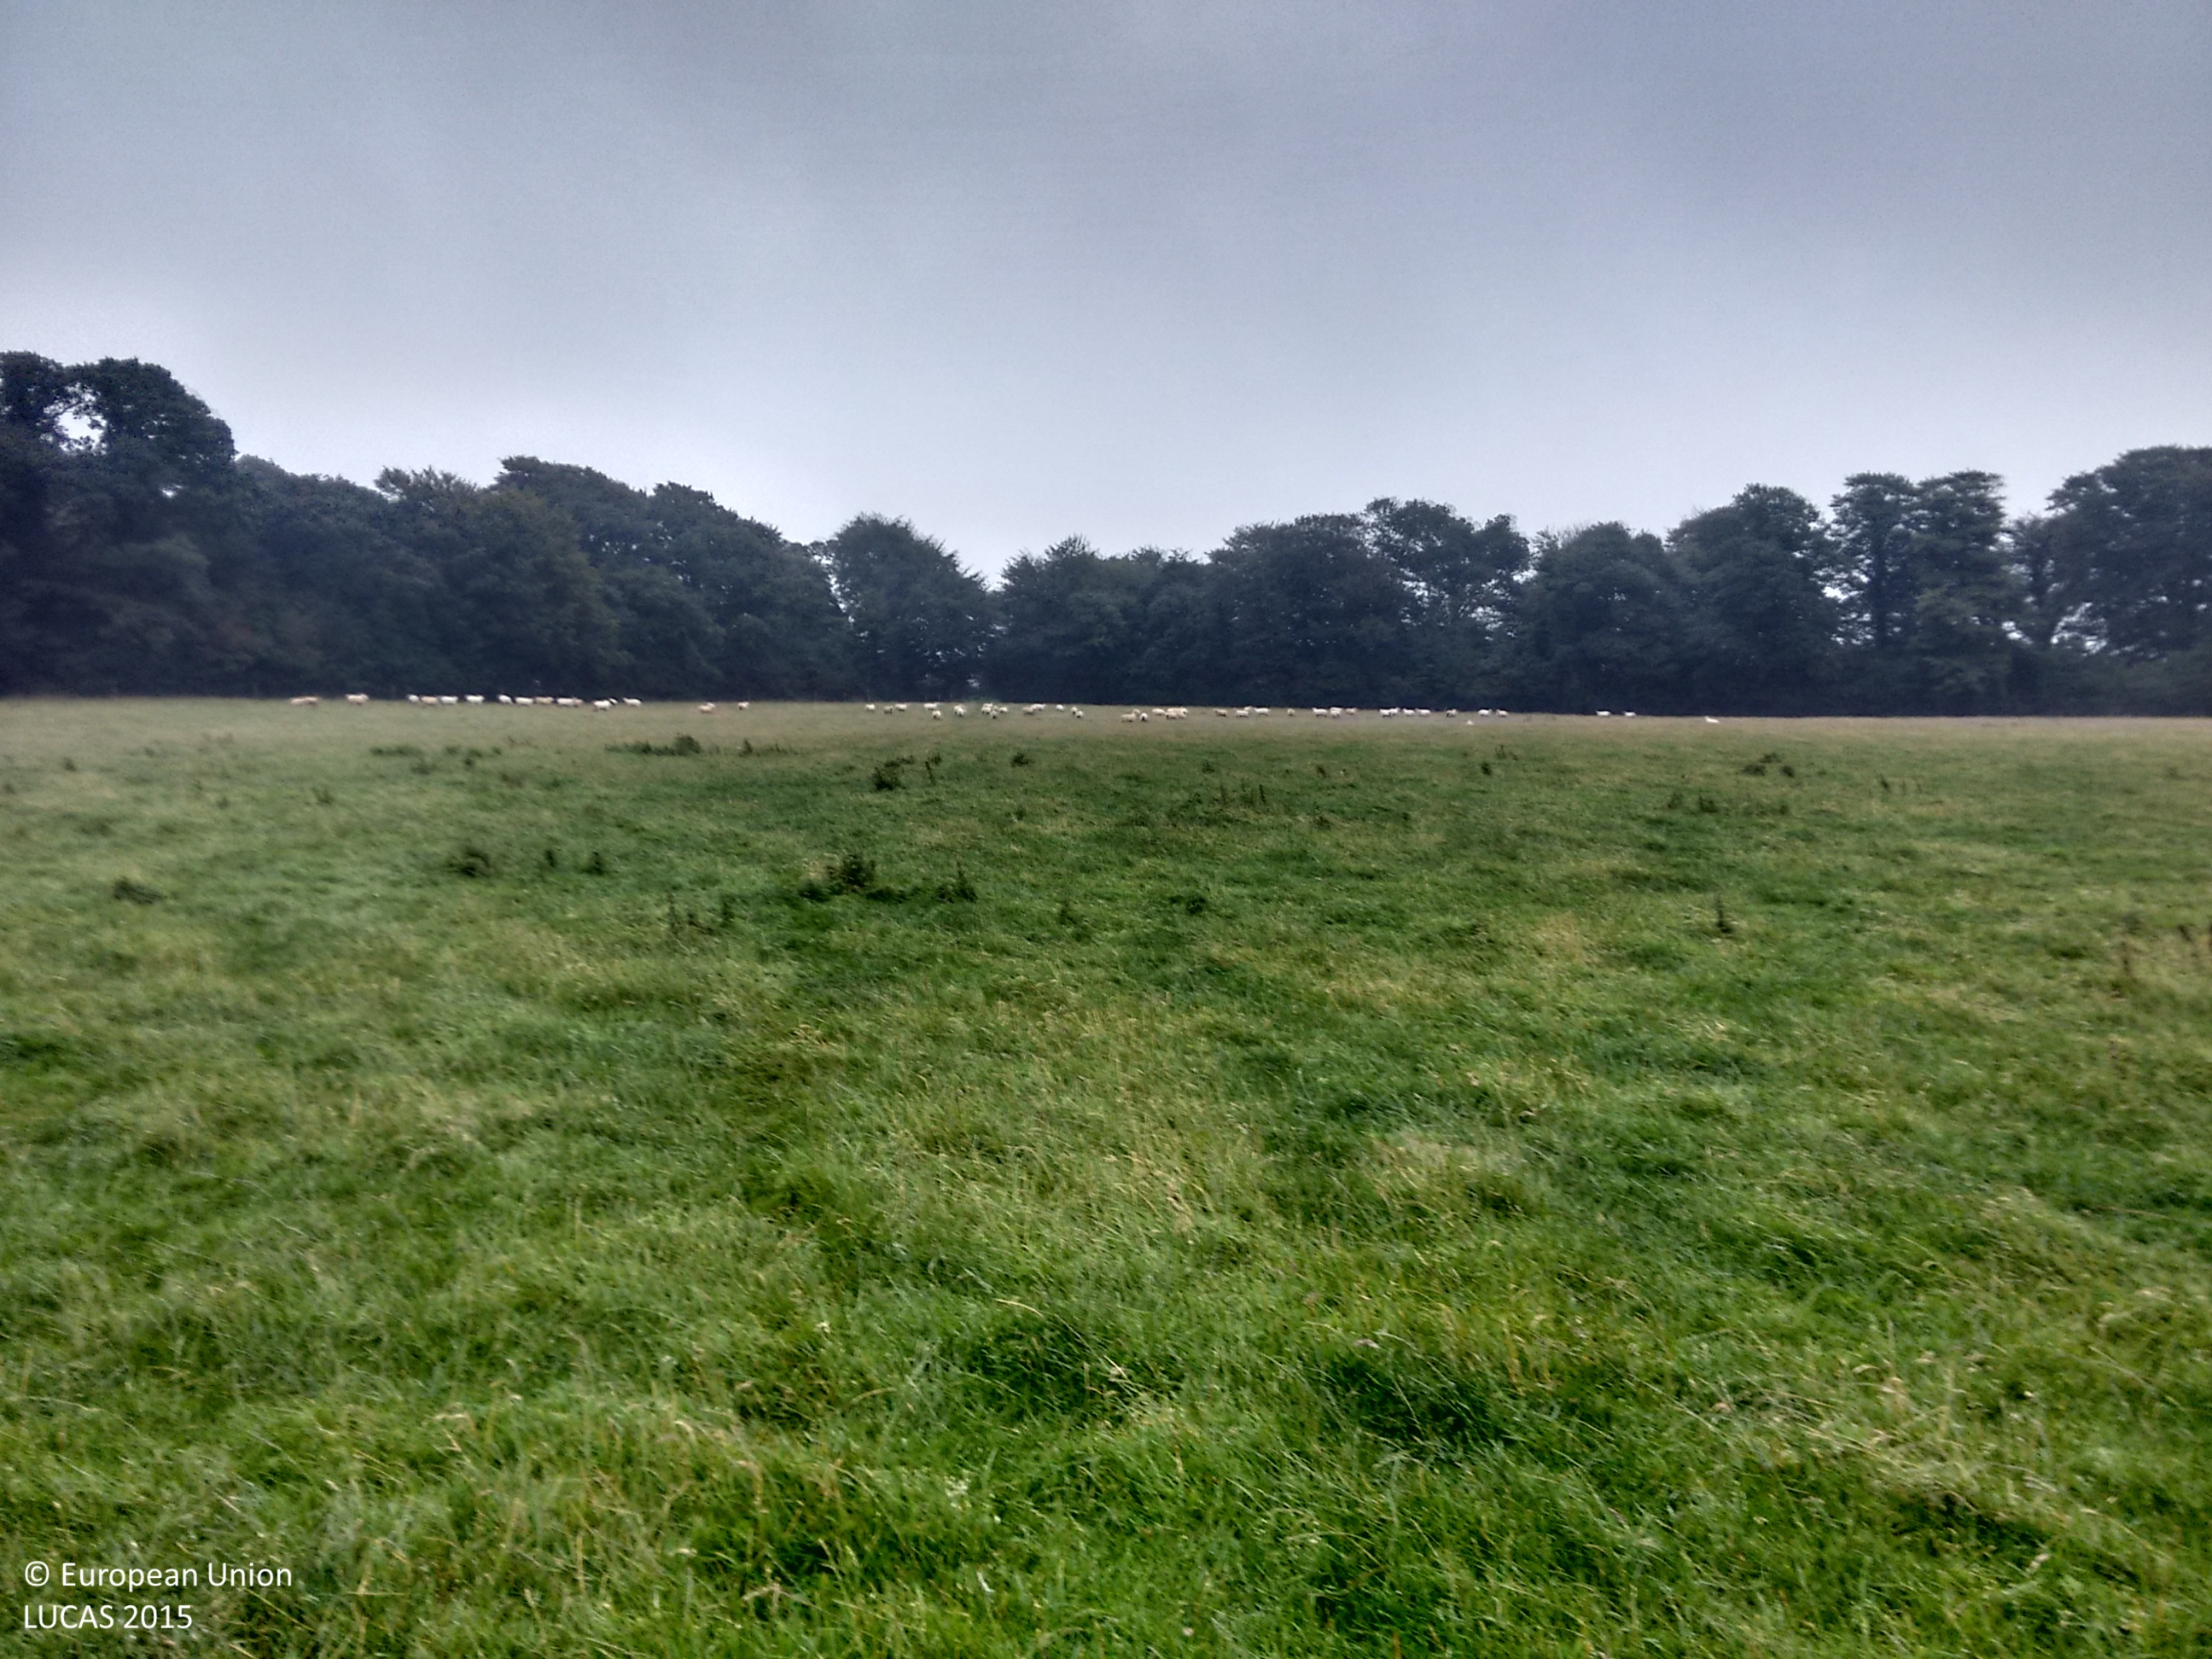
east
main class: Grassland
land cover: Grassland without tree/shrub cover
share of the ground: > 75 %
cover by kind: herbaceous plants 100 %
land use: Agriculture (excluding fallow land and kitchen gardens)
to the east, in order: Grassland without tree/shrub cover; Fences; Broadleaved woodland; Grassland without tree/shrub cover; Fences; Abandoned hedges; Artificial constructions in urban areas
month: August
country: IE
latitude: 52.7480
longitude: -6.2838
